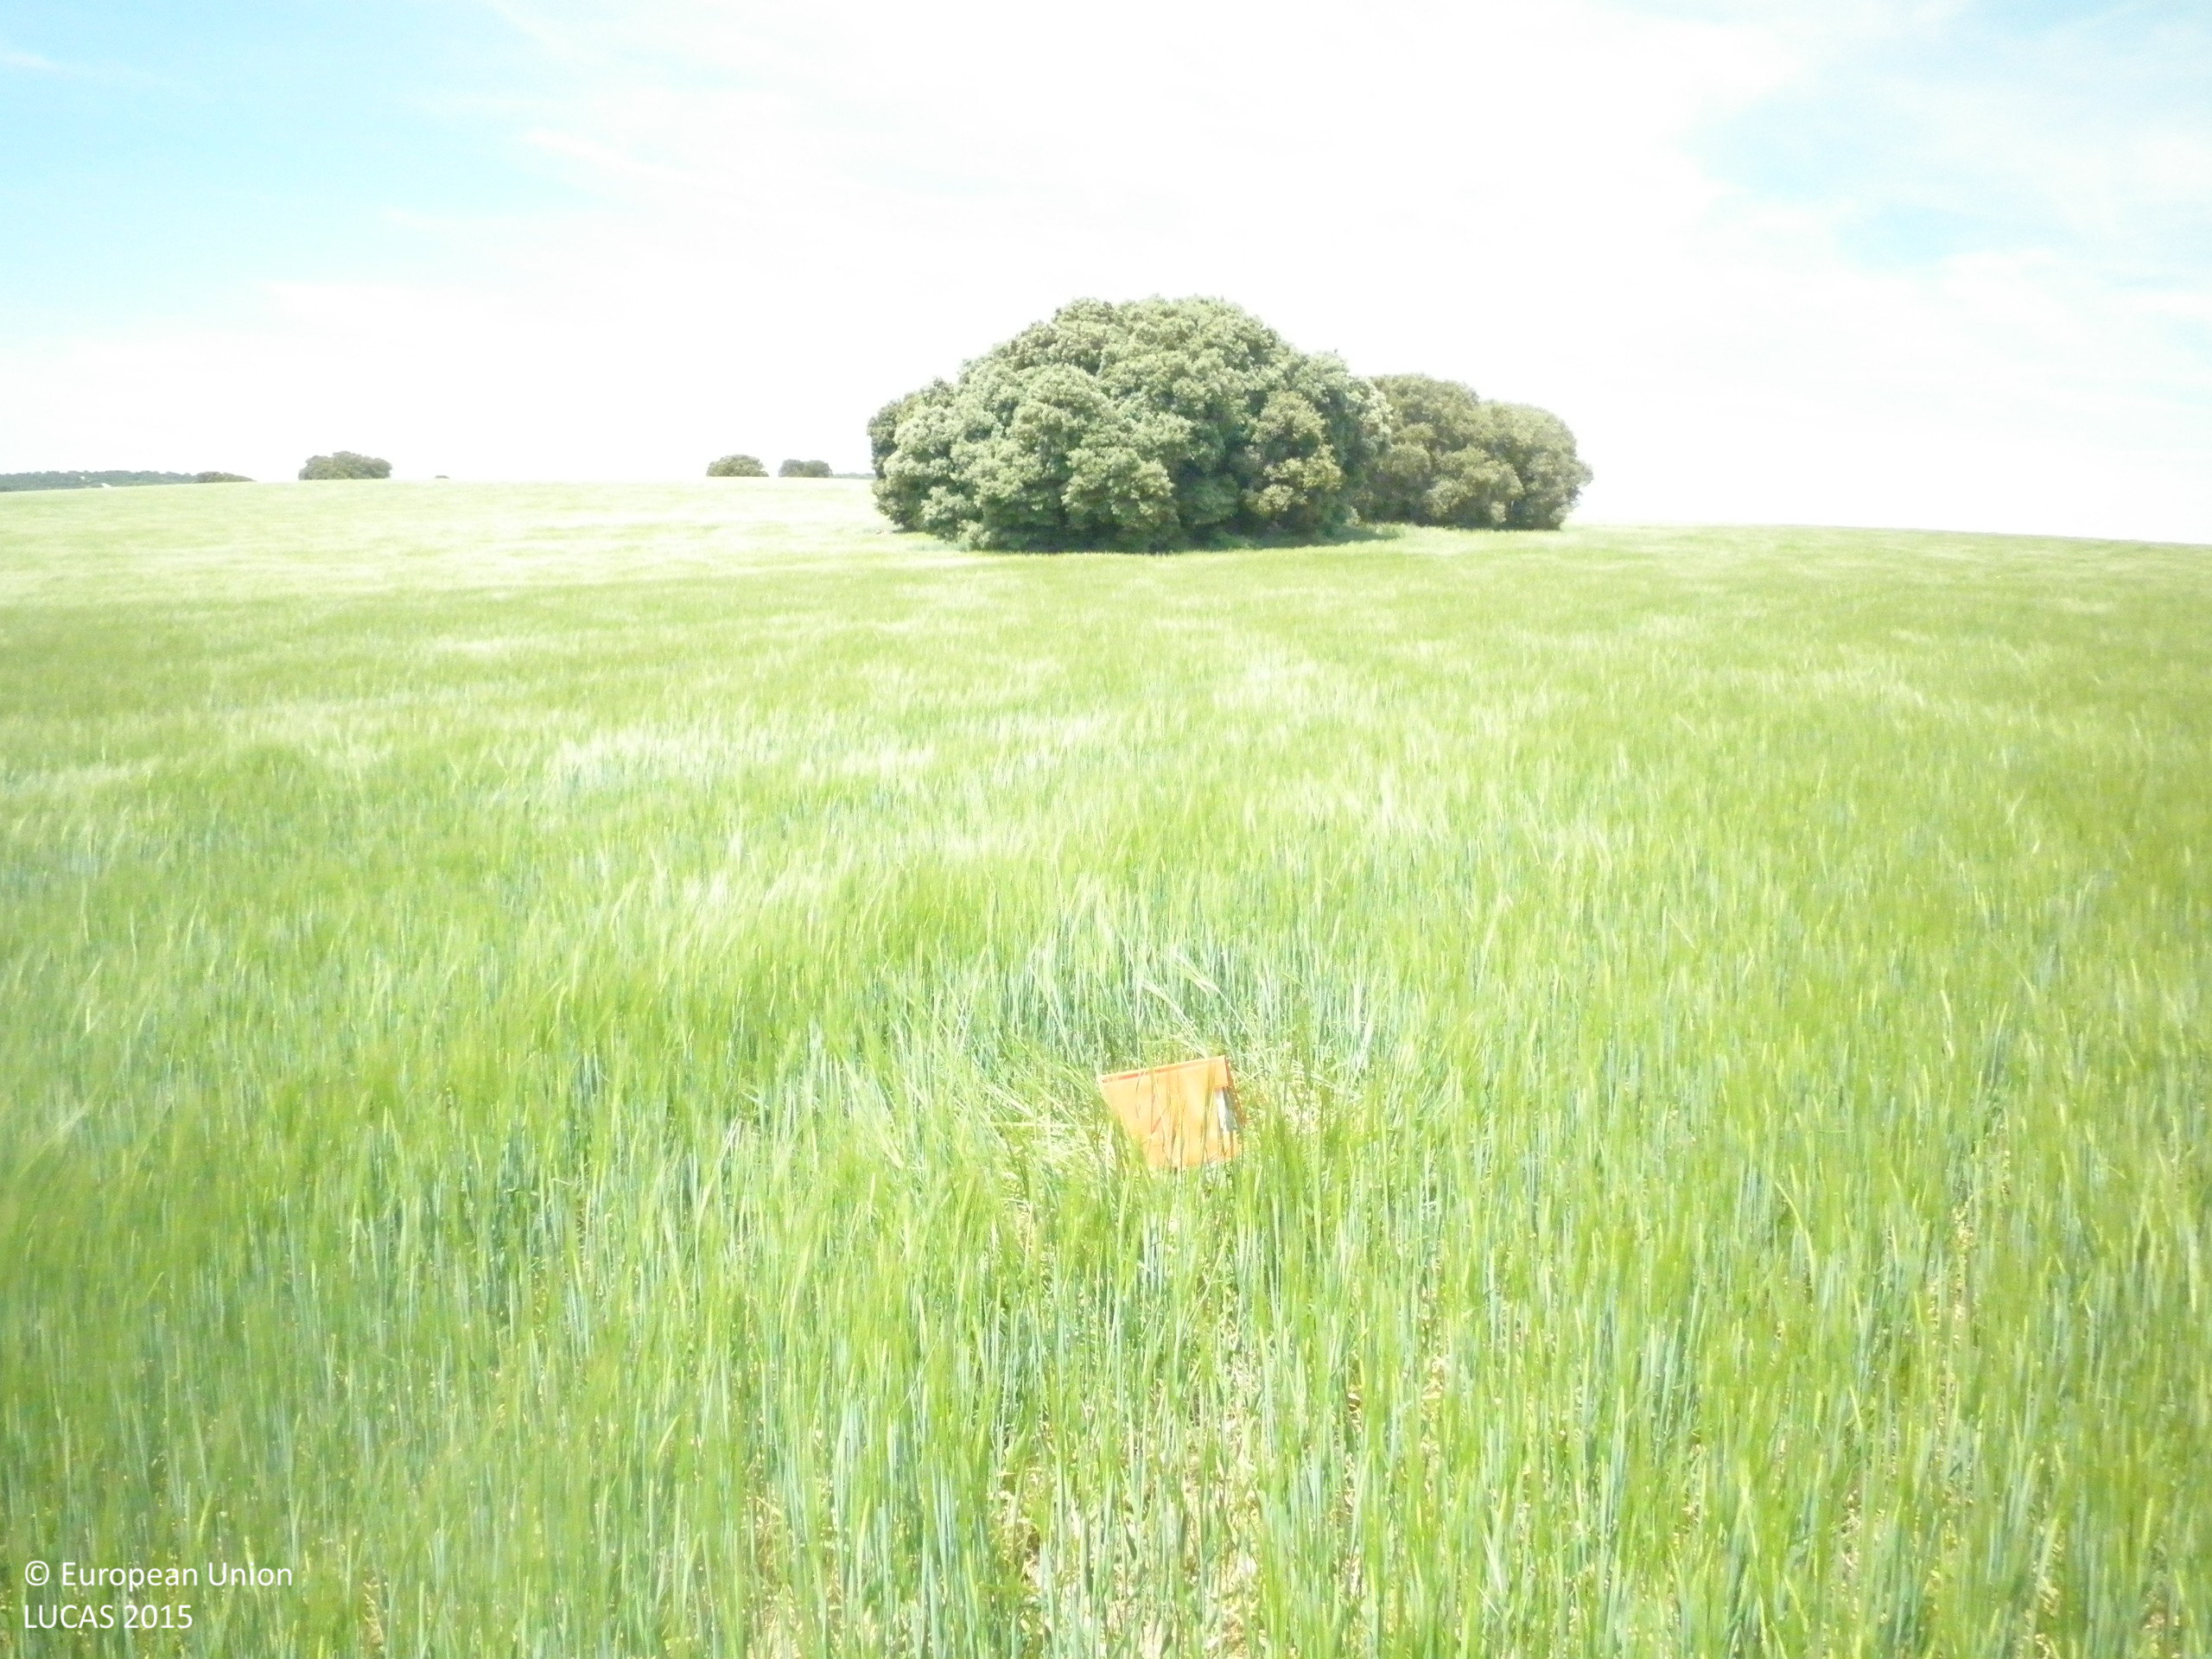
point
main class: Cropland
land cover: Barley
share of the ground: > 75 %
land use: Agriculture (excluding fallow land and kitchen gardens)
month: May
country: ES
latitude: 39.7015
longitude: -2.6468
